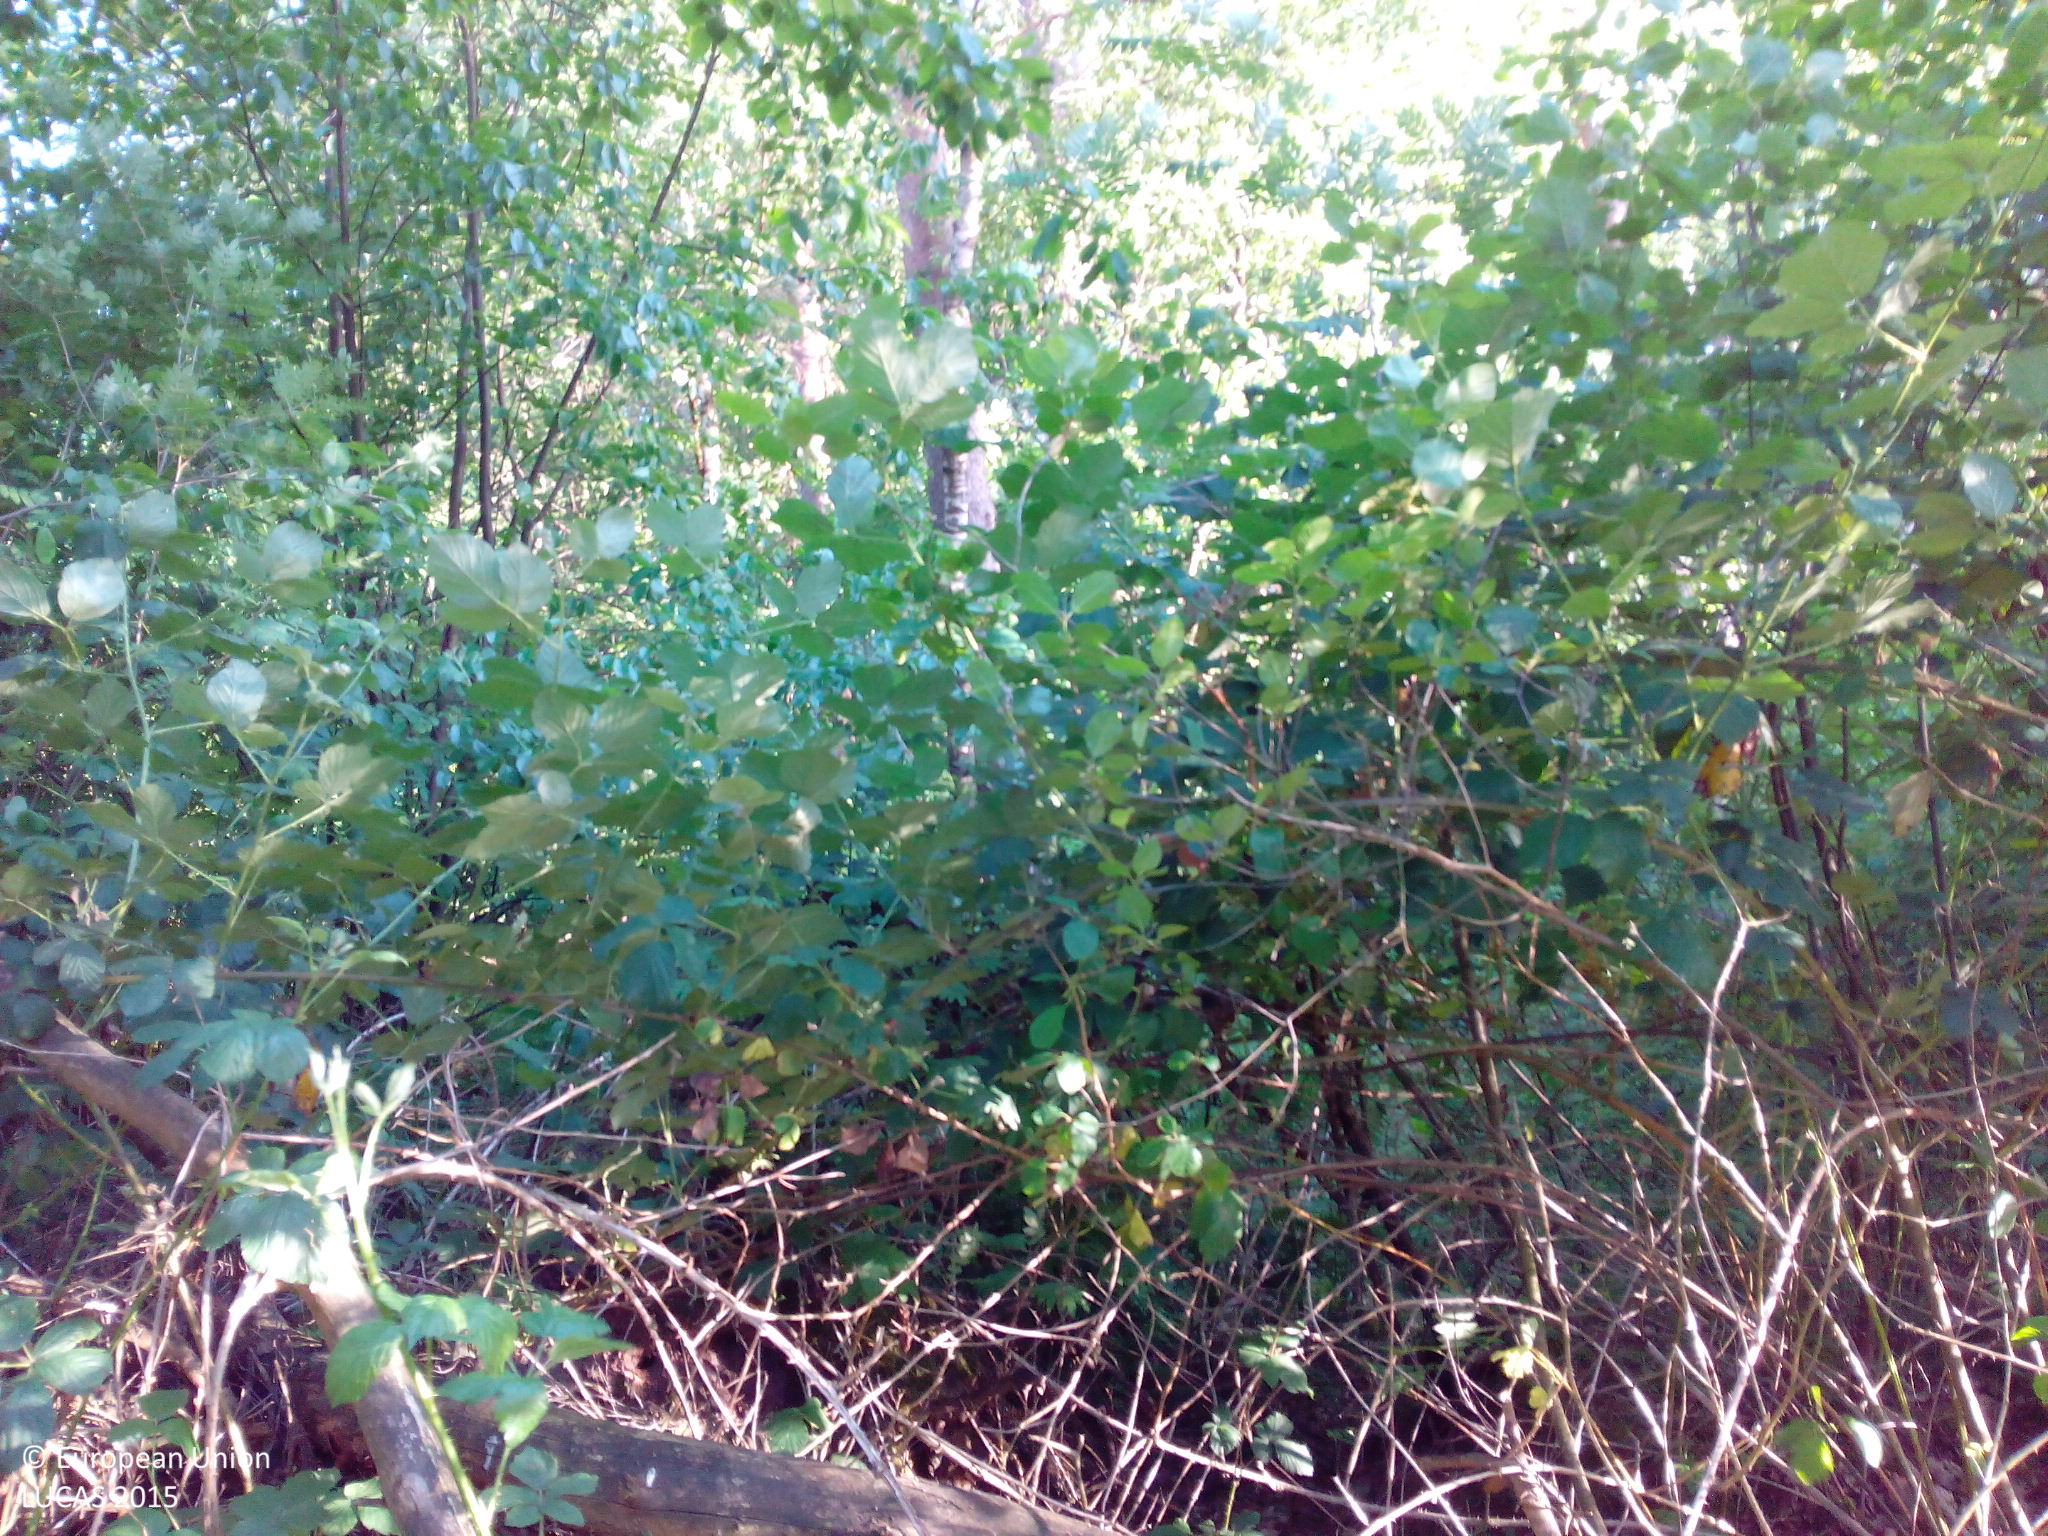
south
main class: Woodland
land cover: Pine dominated coniferous woodland
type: hemiboreal forest and nemoral coniferous forest and mixed broadleaved-coniferous forest
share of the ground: > 75 %
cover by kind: coniferous forest trees 70 %, broadleaved forest trees 15 %, shrubs 10 %, herbaceous plants 5 %
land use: Forestry
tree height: > 5 m
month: June
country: DE
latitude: 52.5101
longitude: 7.3629
